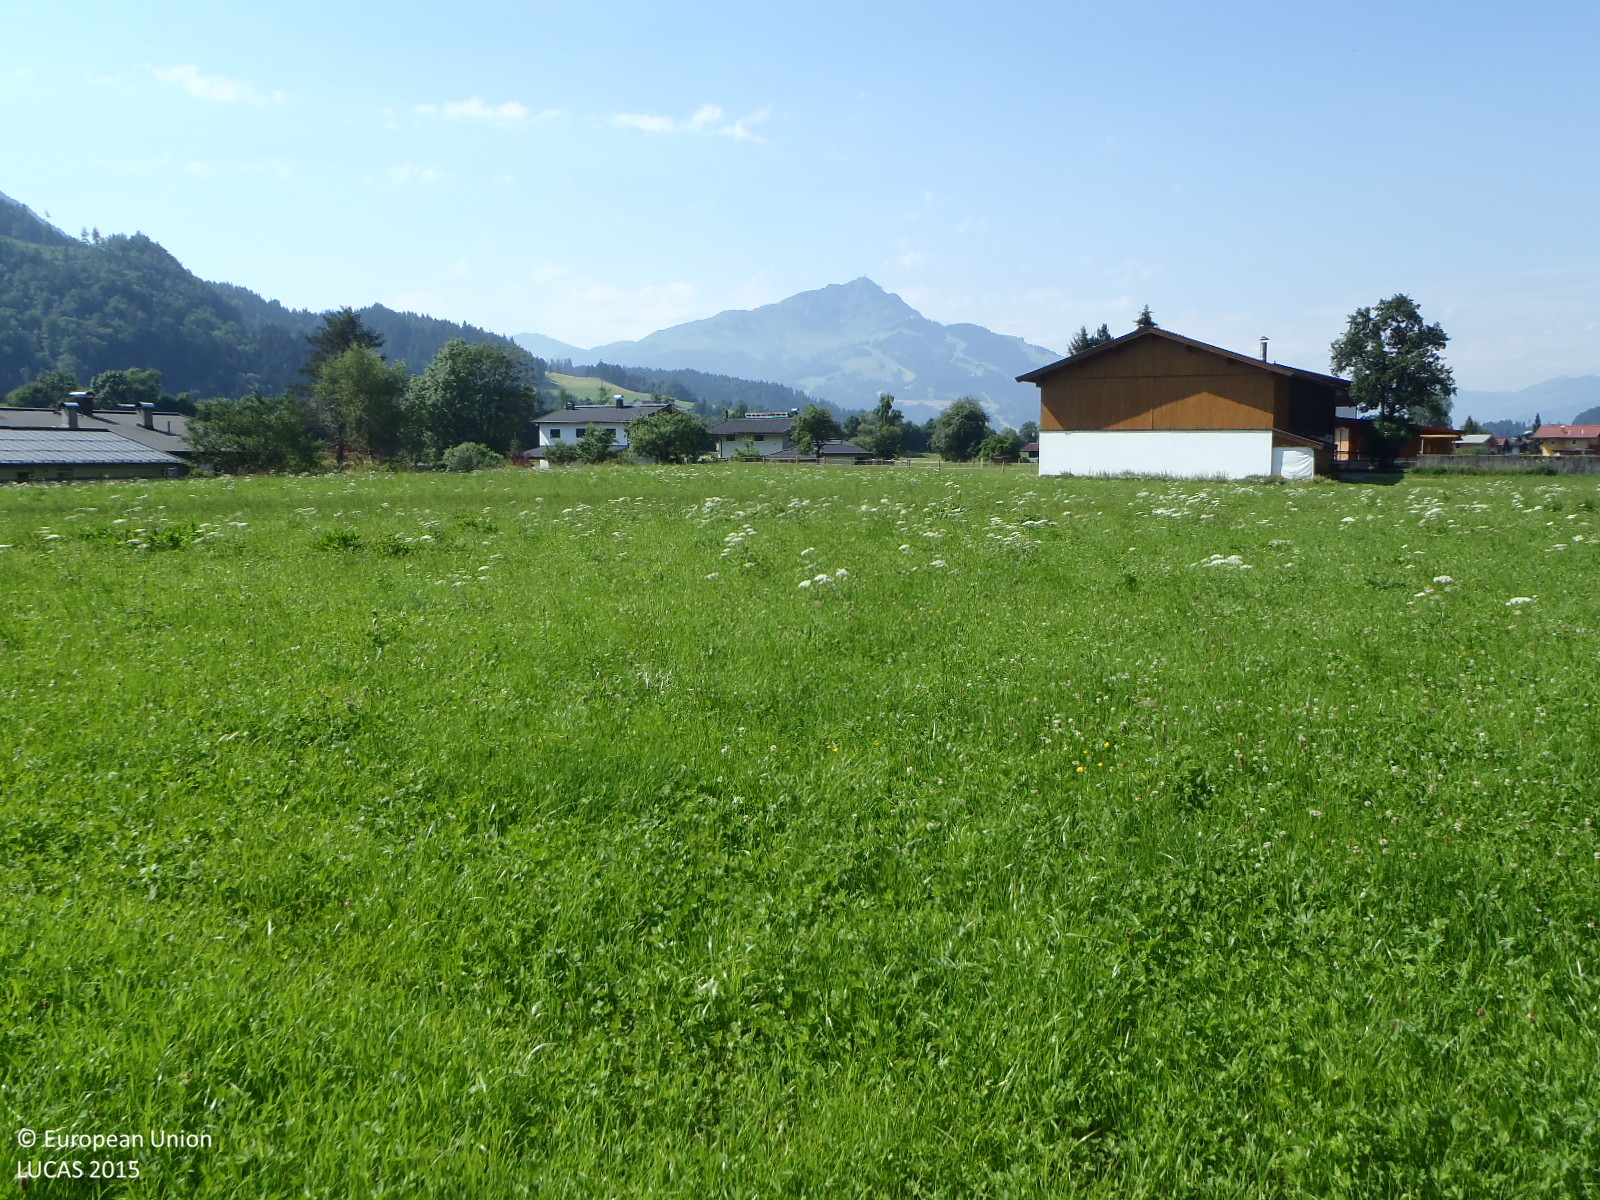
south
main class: Grassland
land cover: Grassland without tree/shrub cover
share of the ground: > 75 %
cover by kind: herbaceous plants 100 %
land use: Agriculture (excluding fallow land and kitchen gardens)
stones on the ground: < 10 %
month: July
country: AT
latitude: 47.5660
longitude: 12.4574
